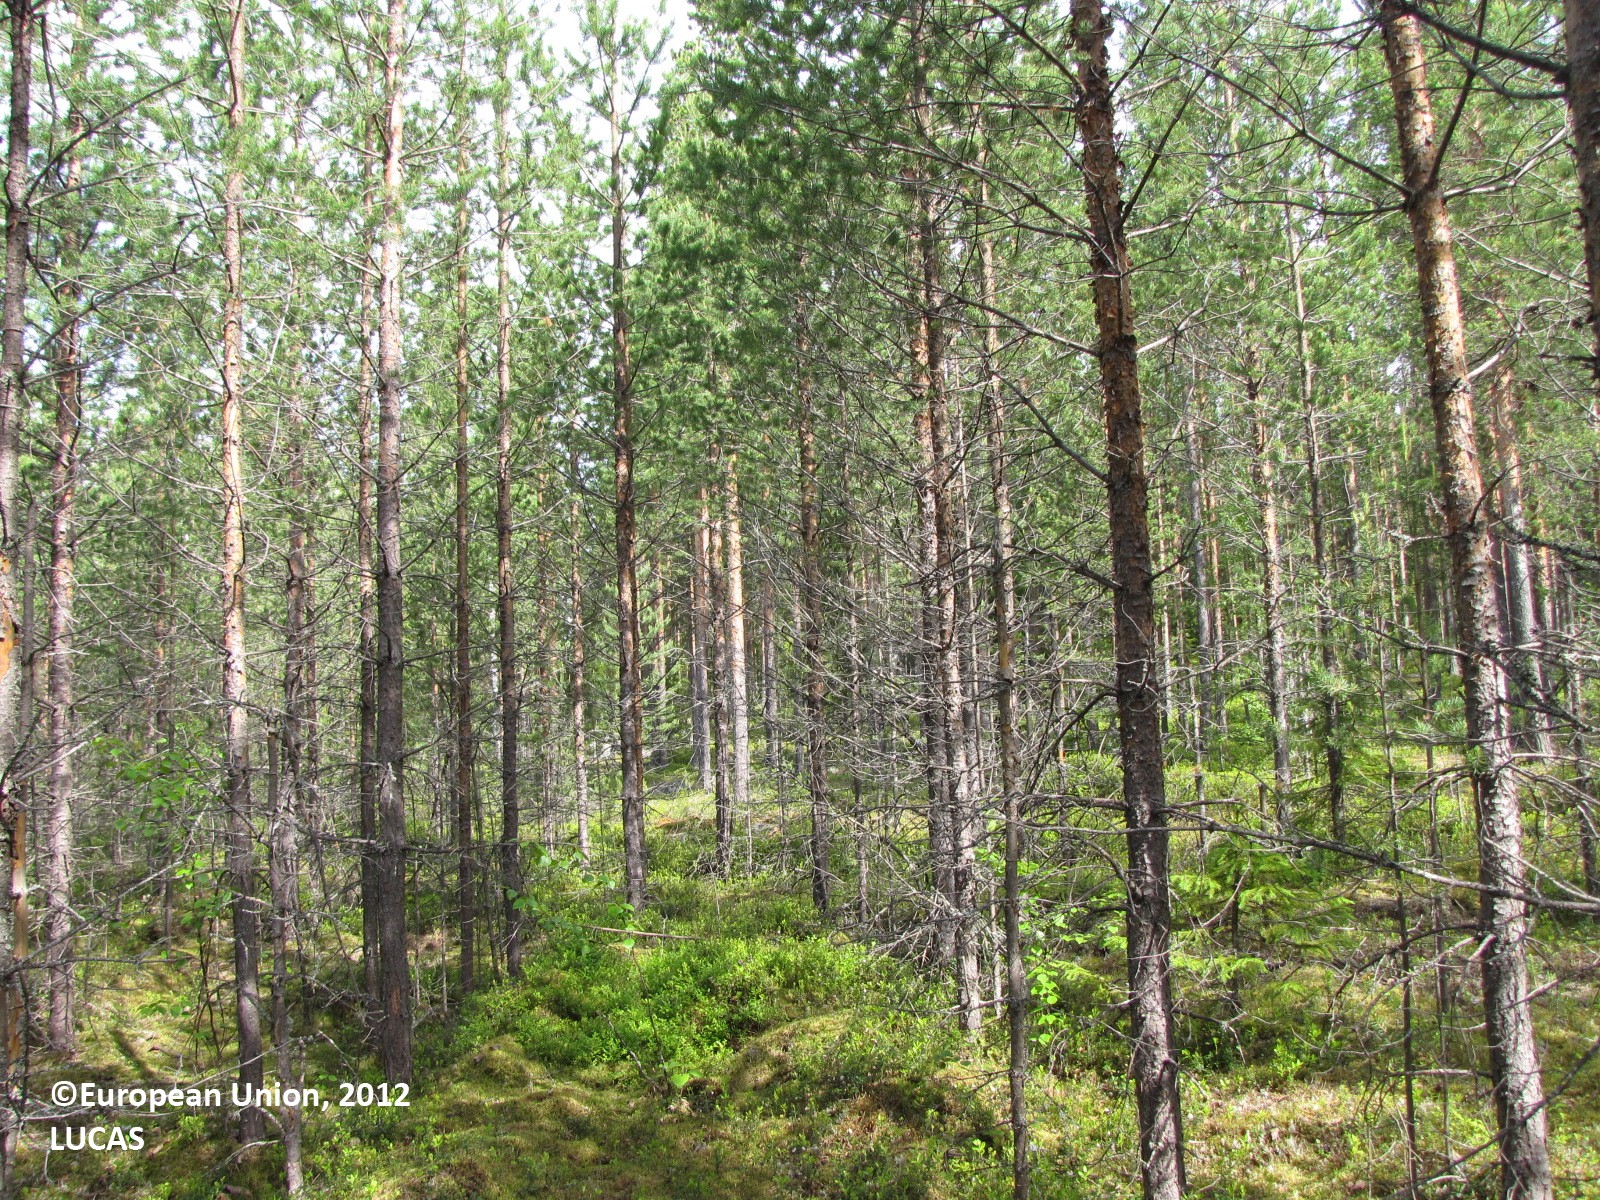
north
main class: Woodland
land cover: Pine dominated coniferous woodland
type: boreal forest
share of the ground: 50 - 75 %
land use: Forestry
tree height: > 5 m
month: July
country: FI
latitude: 66.1342
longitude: 25.2360
